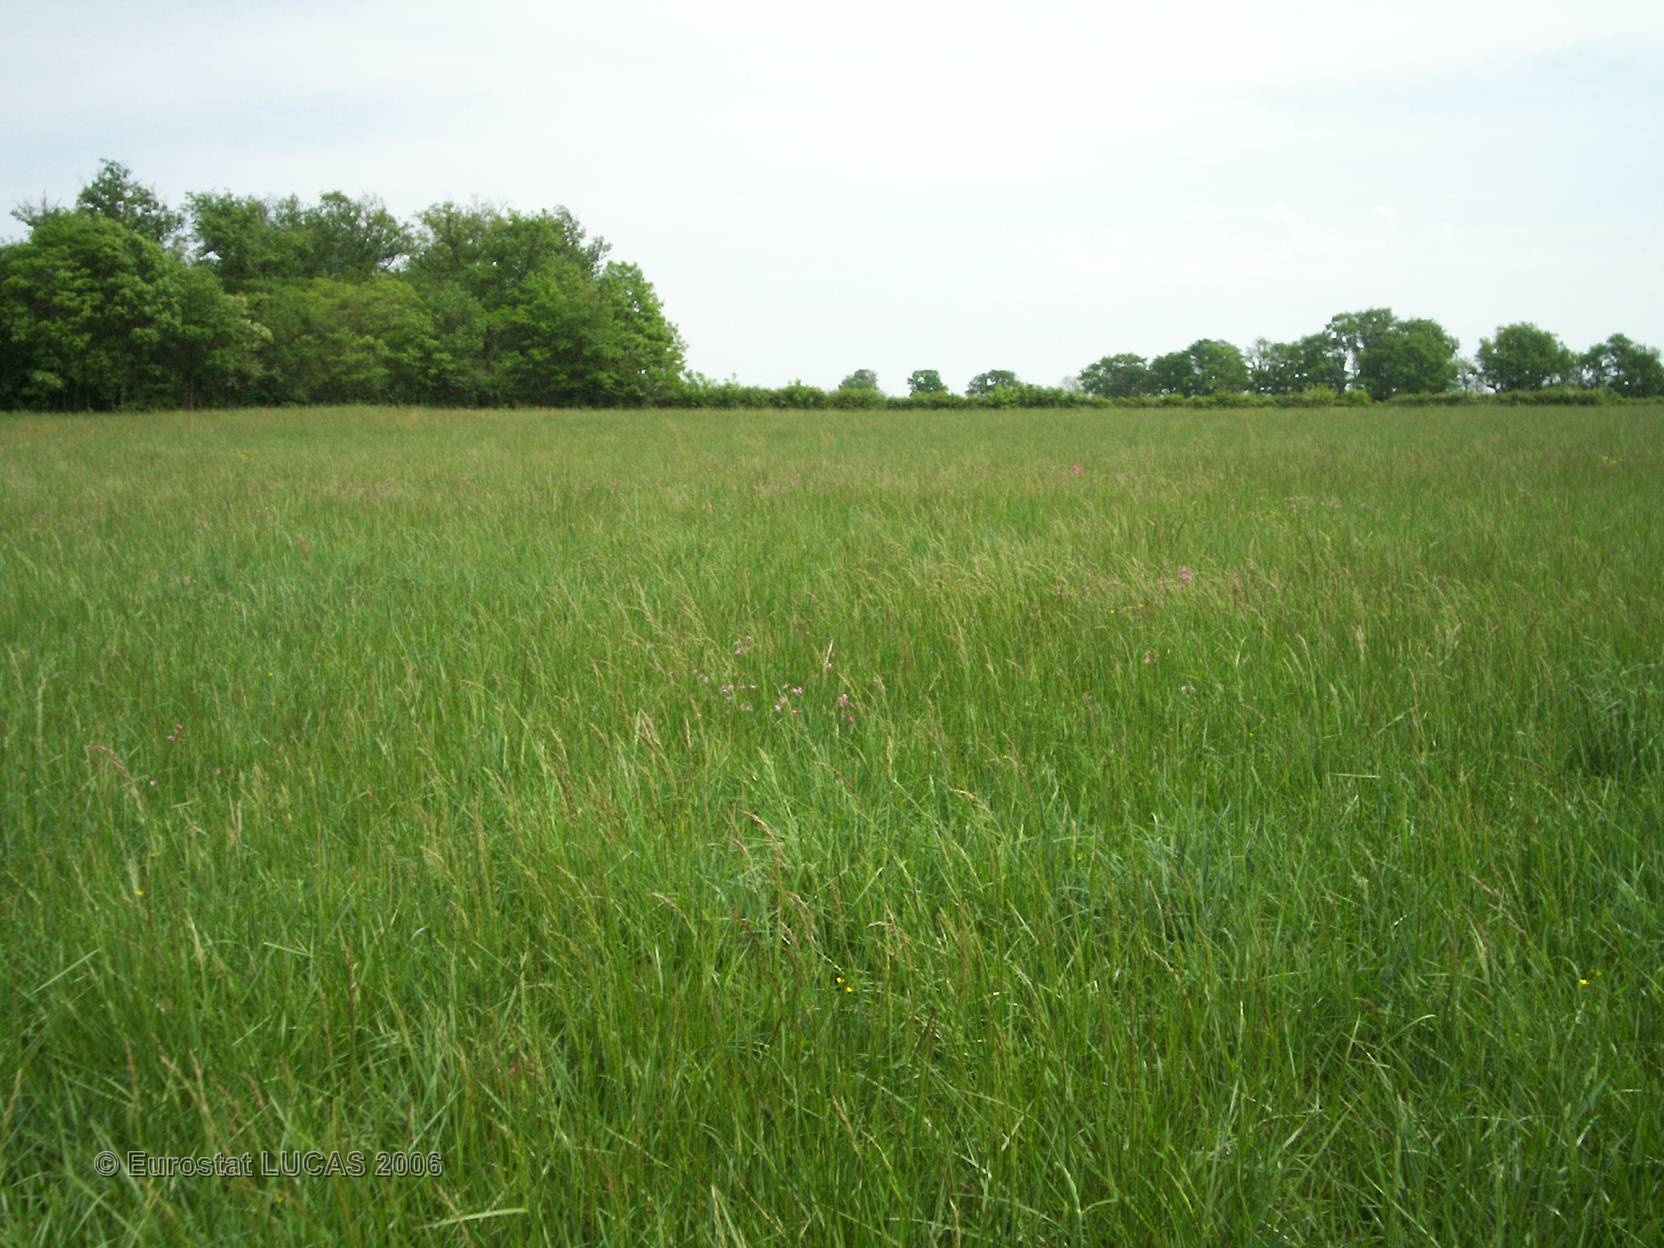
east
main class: Grassland
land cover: Grassland without tree/shrub cover
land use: Agriculture (excluding fallow land and kitchen gardens)
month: May
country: FR
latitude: 46.7338
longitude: 1.0214
